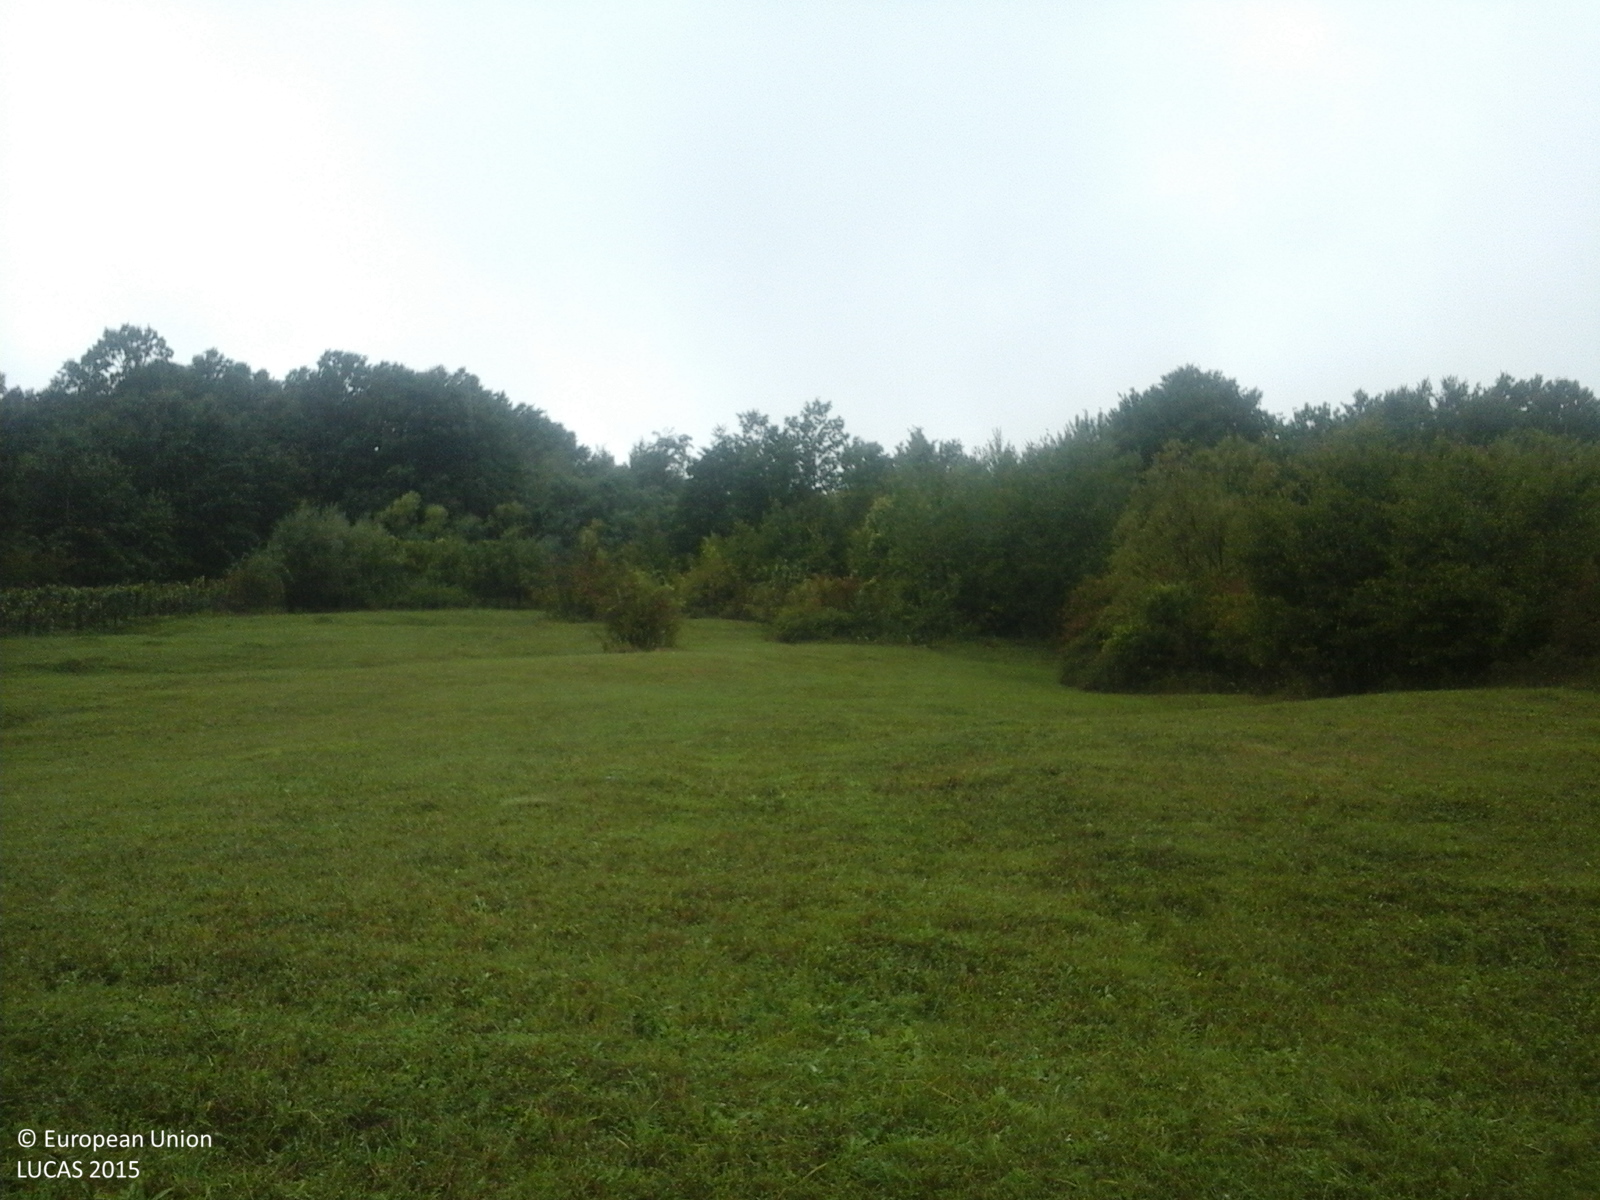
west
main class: Grassland
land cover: Grassland without tree/shrub cover
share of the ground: > 75 %
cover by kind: herbaceous plants 100 %
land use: Agriculture (excluding fallow land and kitchen gardens)
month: September
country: RO
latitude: 45.1451
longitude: 23.6307
